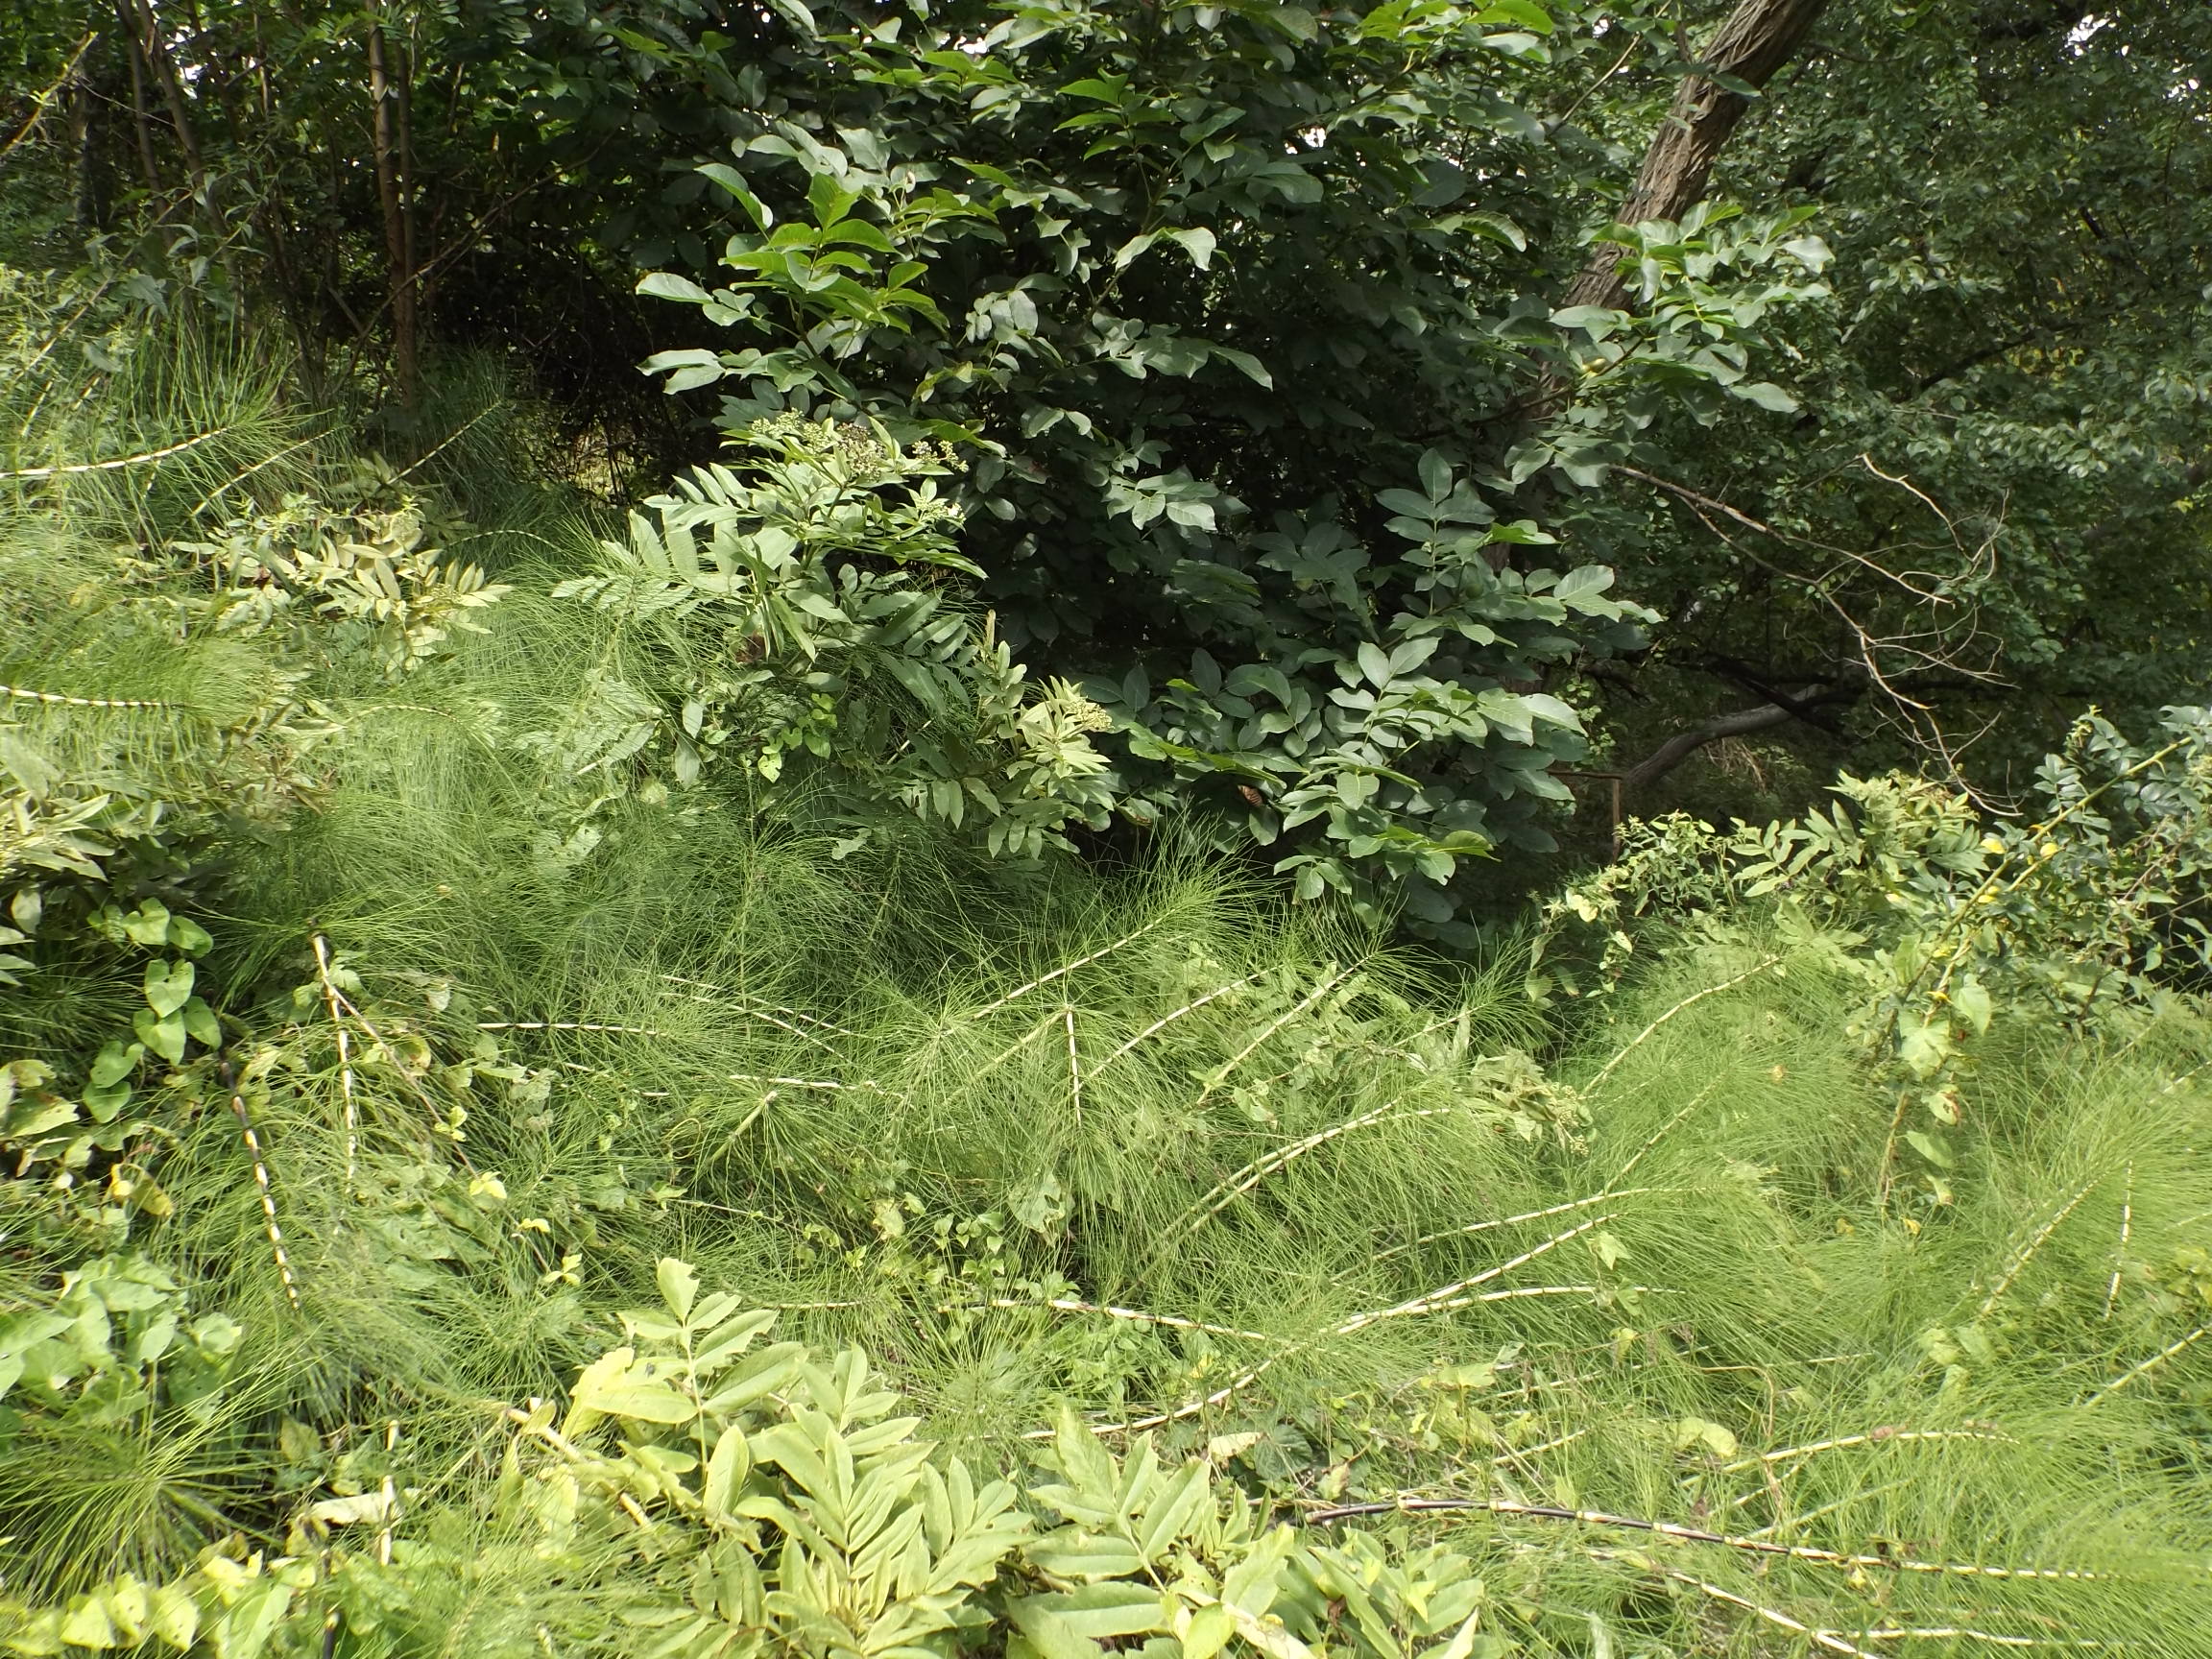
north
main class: Woodland
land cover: Broadleaved woodland
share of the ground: 50 - 75 %
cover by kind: broadleaved forest trees 65 %, herbaceous plants 25 %, shrubs 10 %
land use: Residential
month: August
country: BG
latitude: 43.2336
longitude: 27.9330
